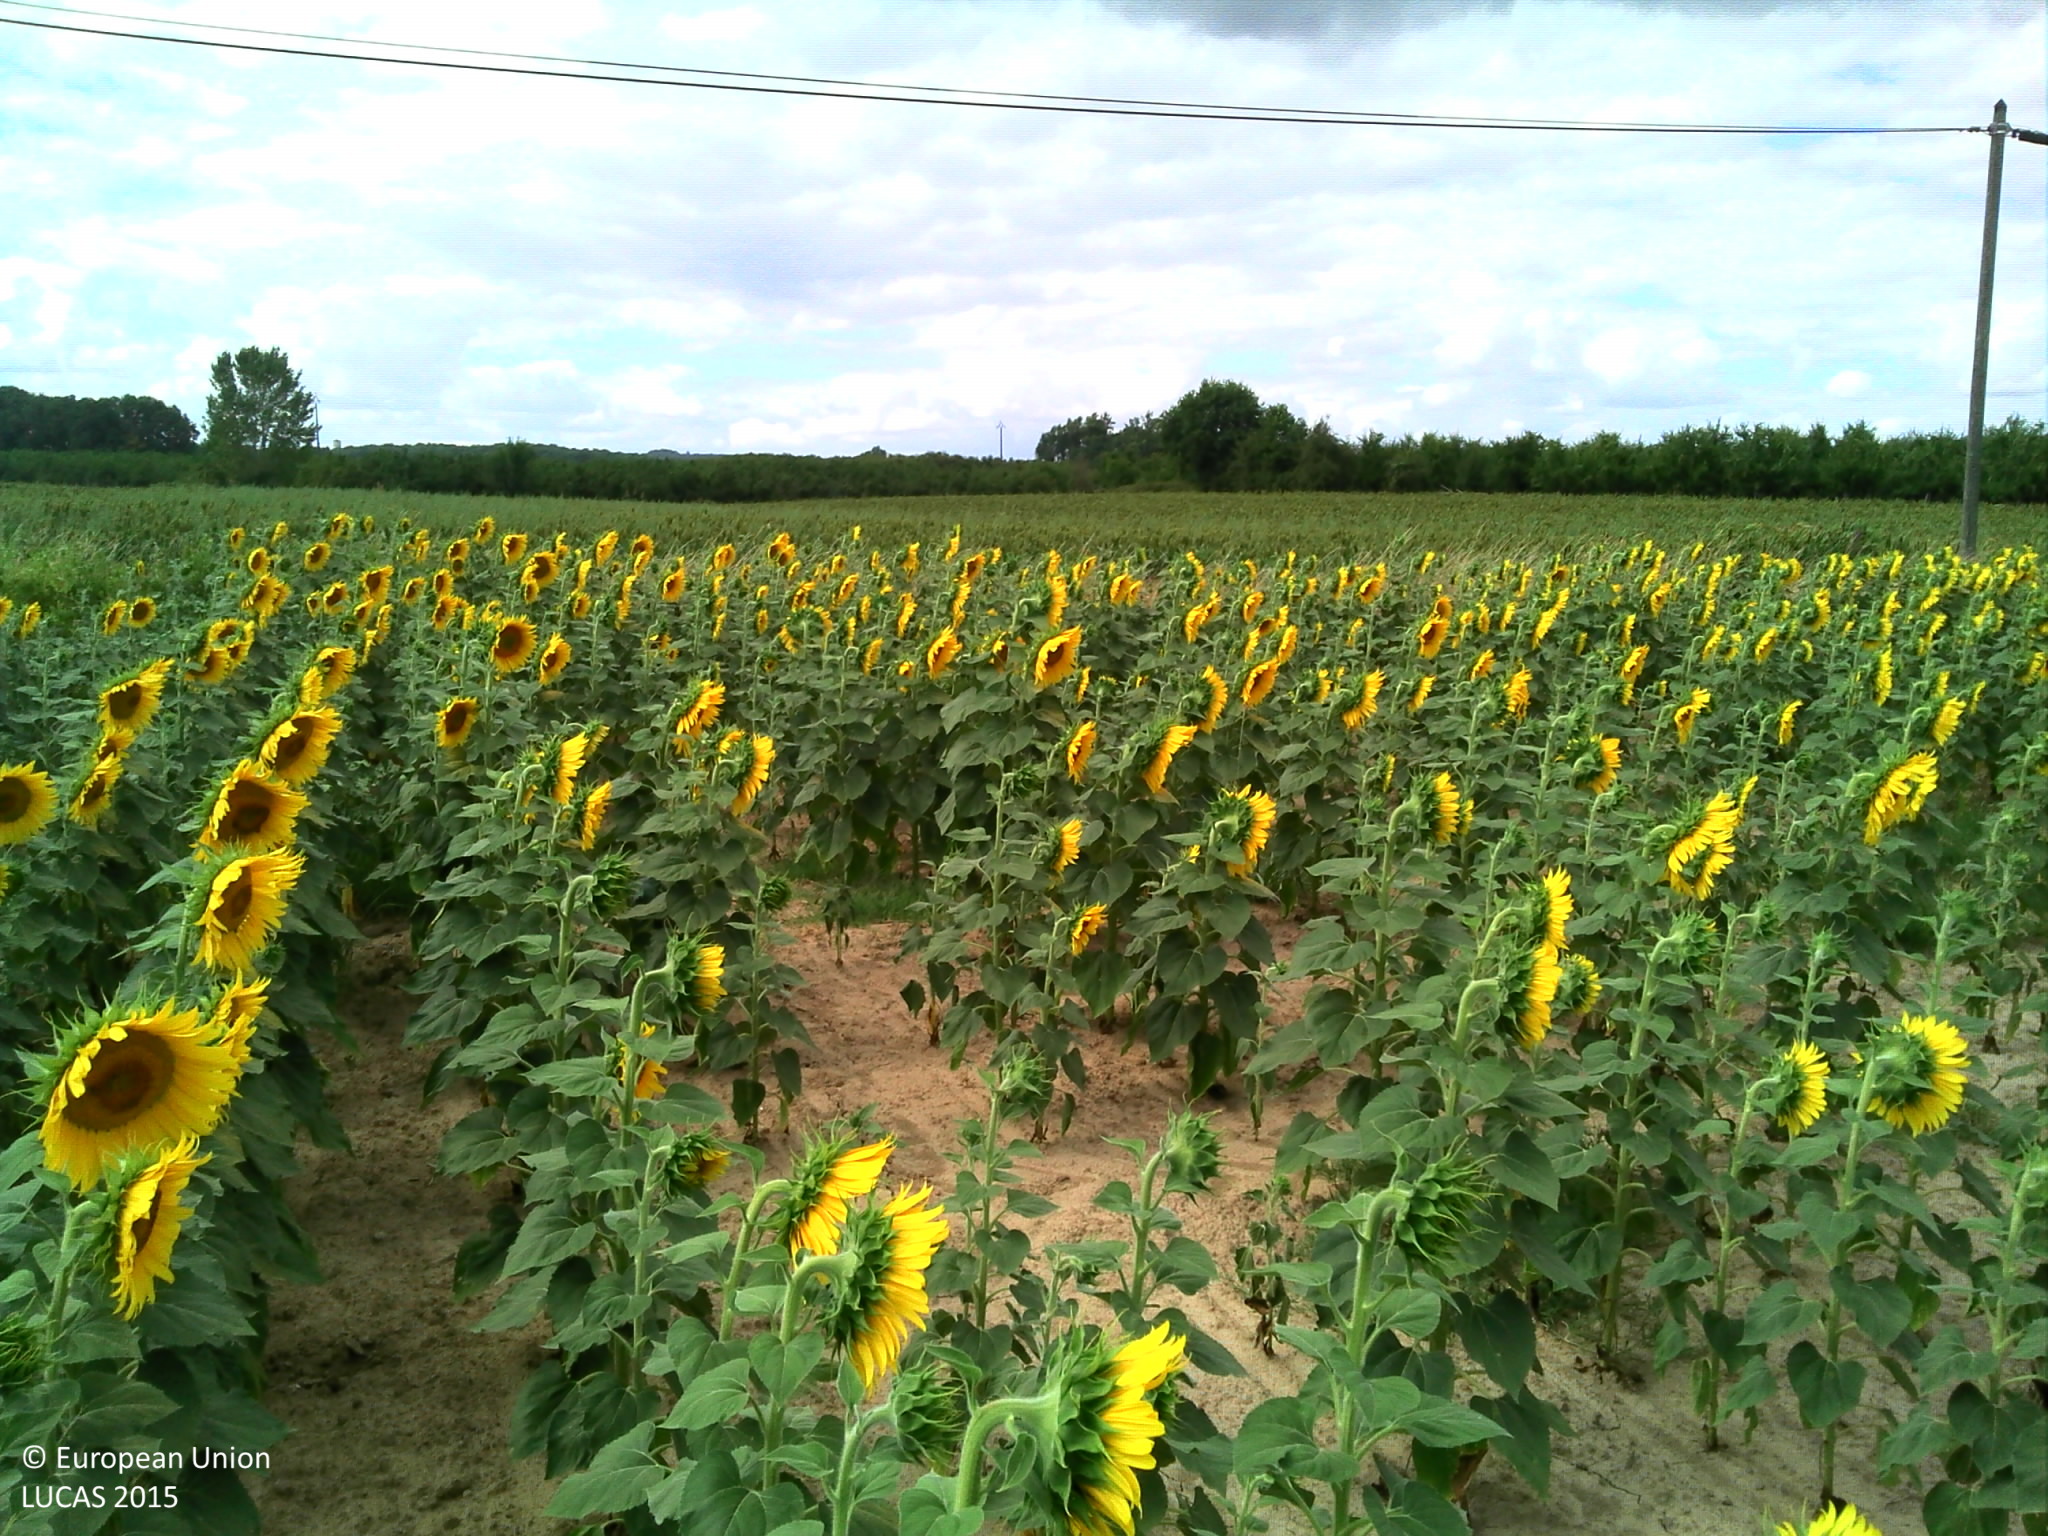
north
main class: Cropland
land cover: Sunflower
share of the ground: 50 - 75 %
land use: Agriculture (excluding fallow land and kitchen gardens)
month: July
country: FR
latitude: 44.4543
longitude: 0.6561
